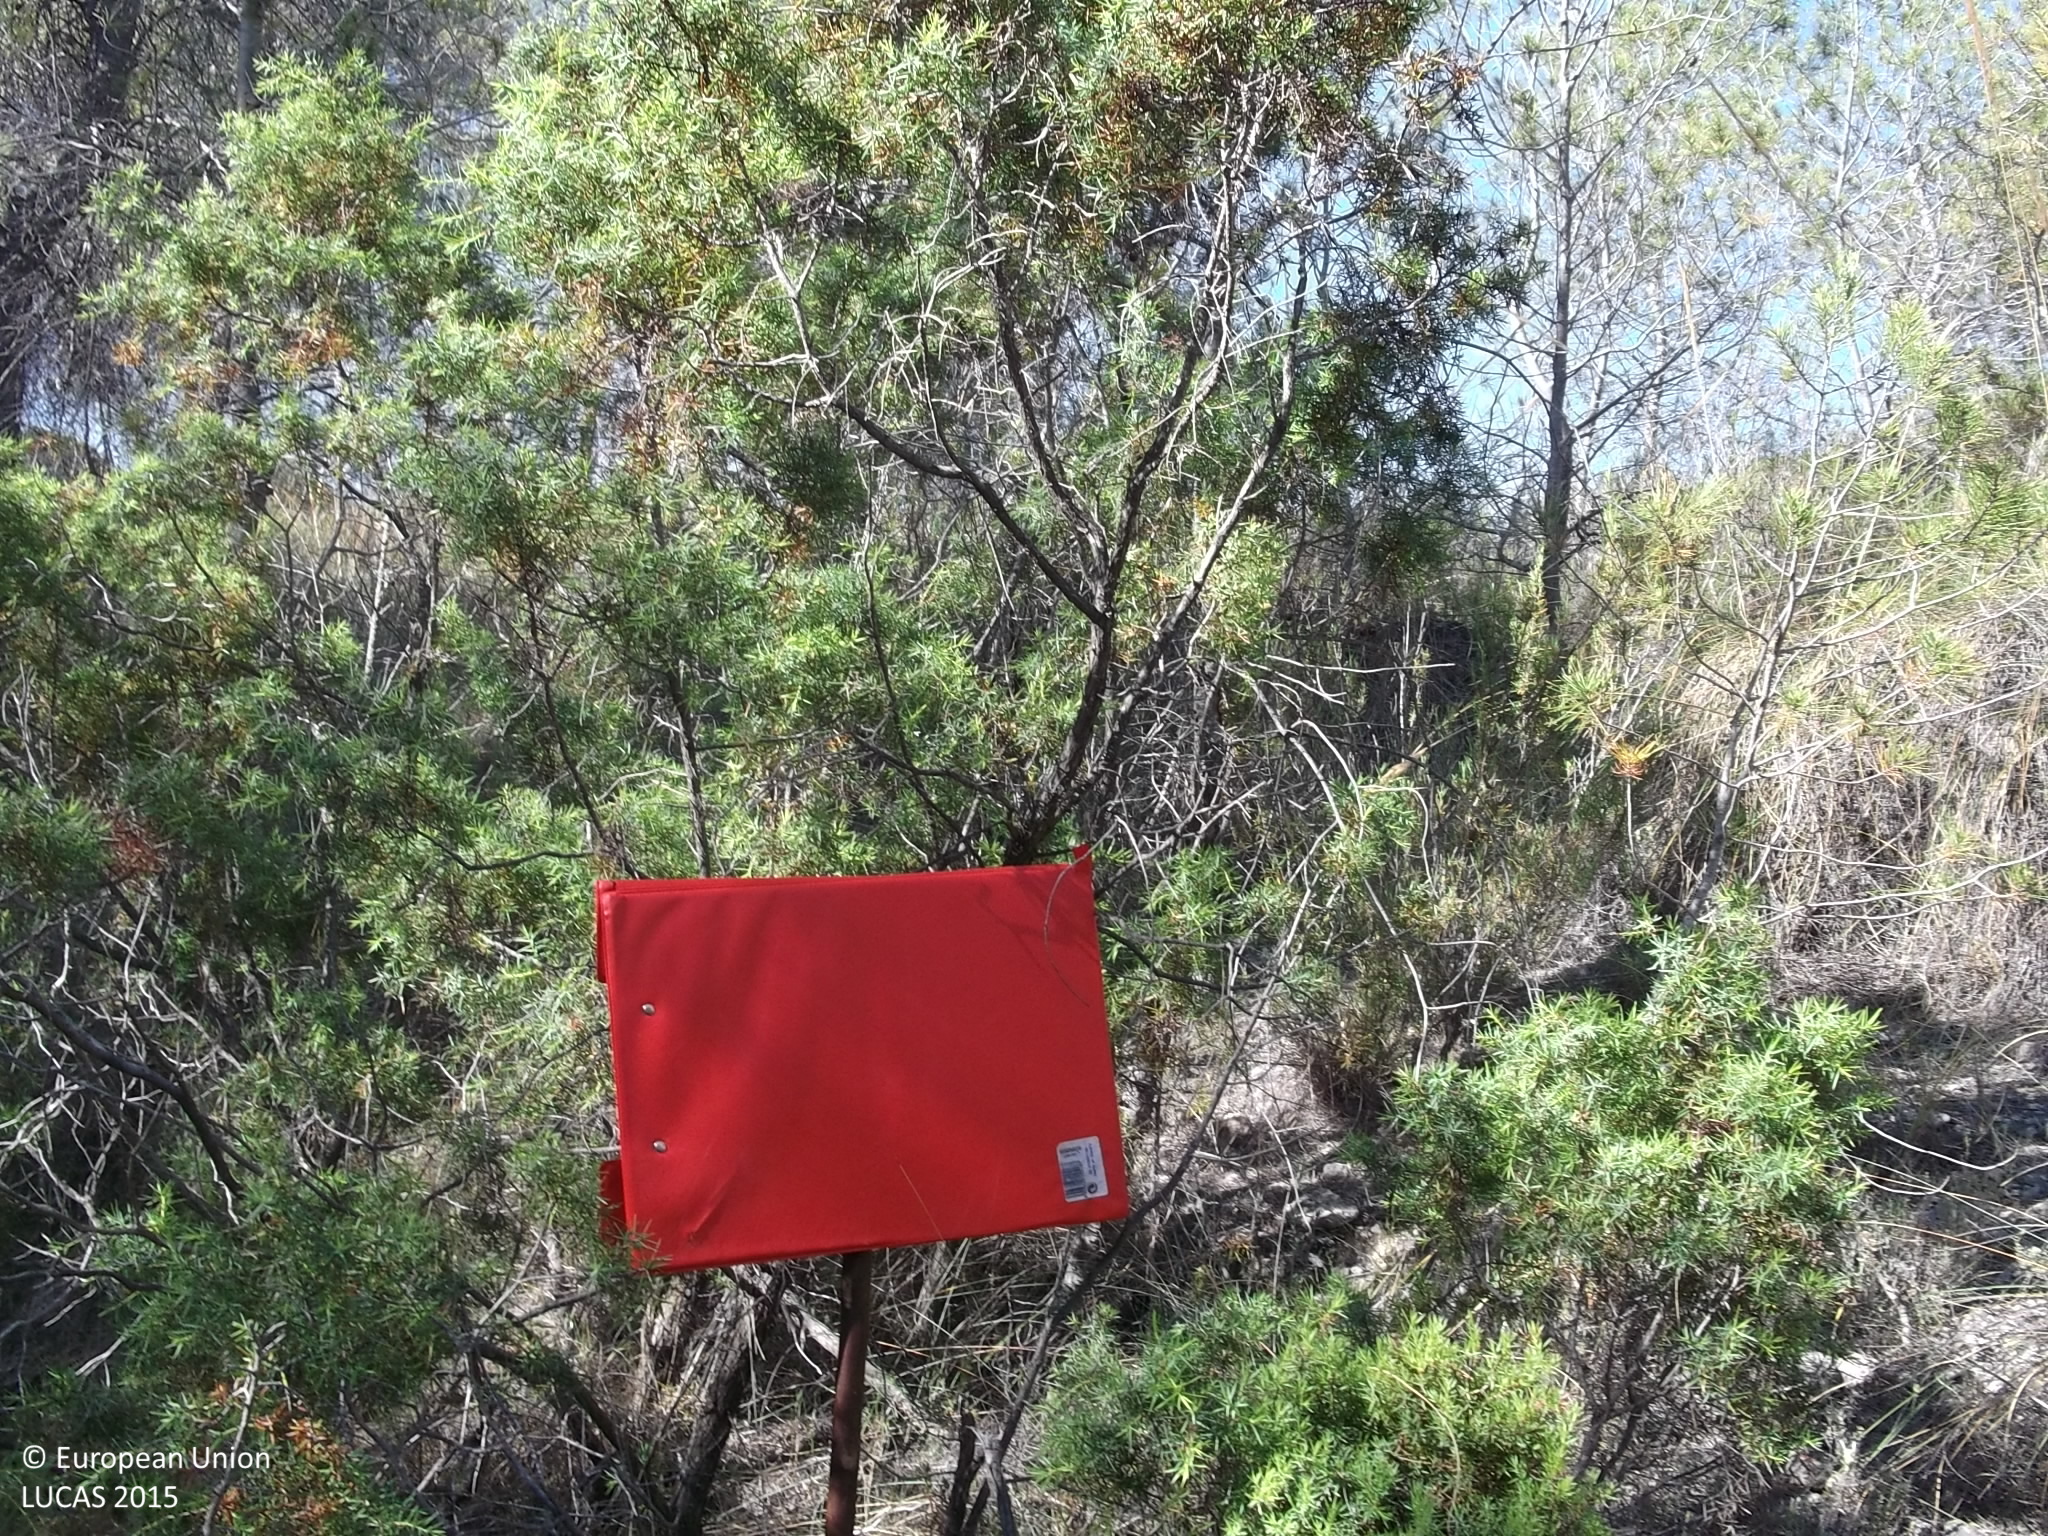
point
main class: Woodland
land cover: Pine dominated coniferous woodland
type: coniferous forest of the mediterranean region
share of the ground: 50 - 75 %
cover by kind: coniferous forest trees 50 %, shrubs 30 %, herbaceous plants 20 %
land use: Forestry
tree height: > 5 m
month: June
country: ES
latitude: 38.2015
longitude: -1.4875
